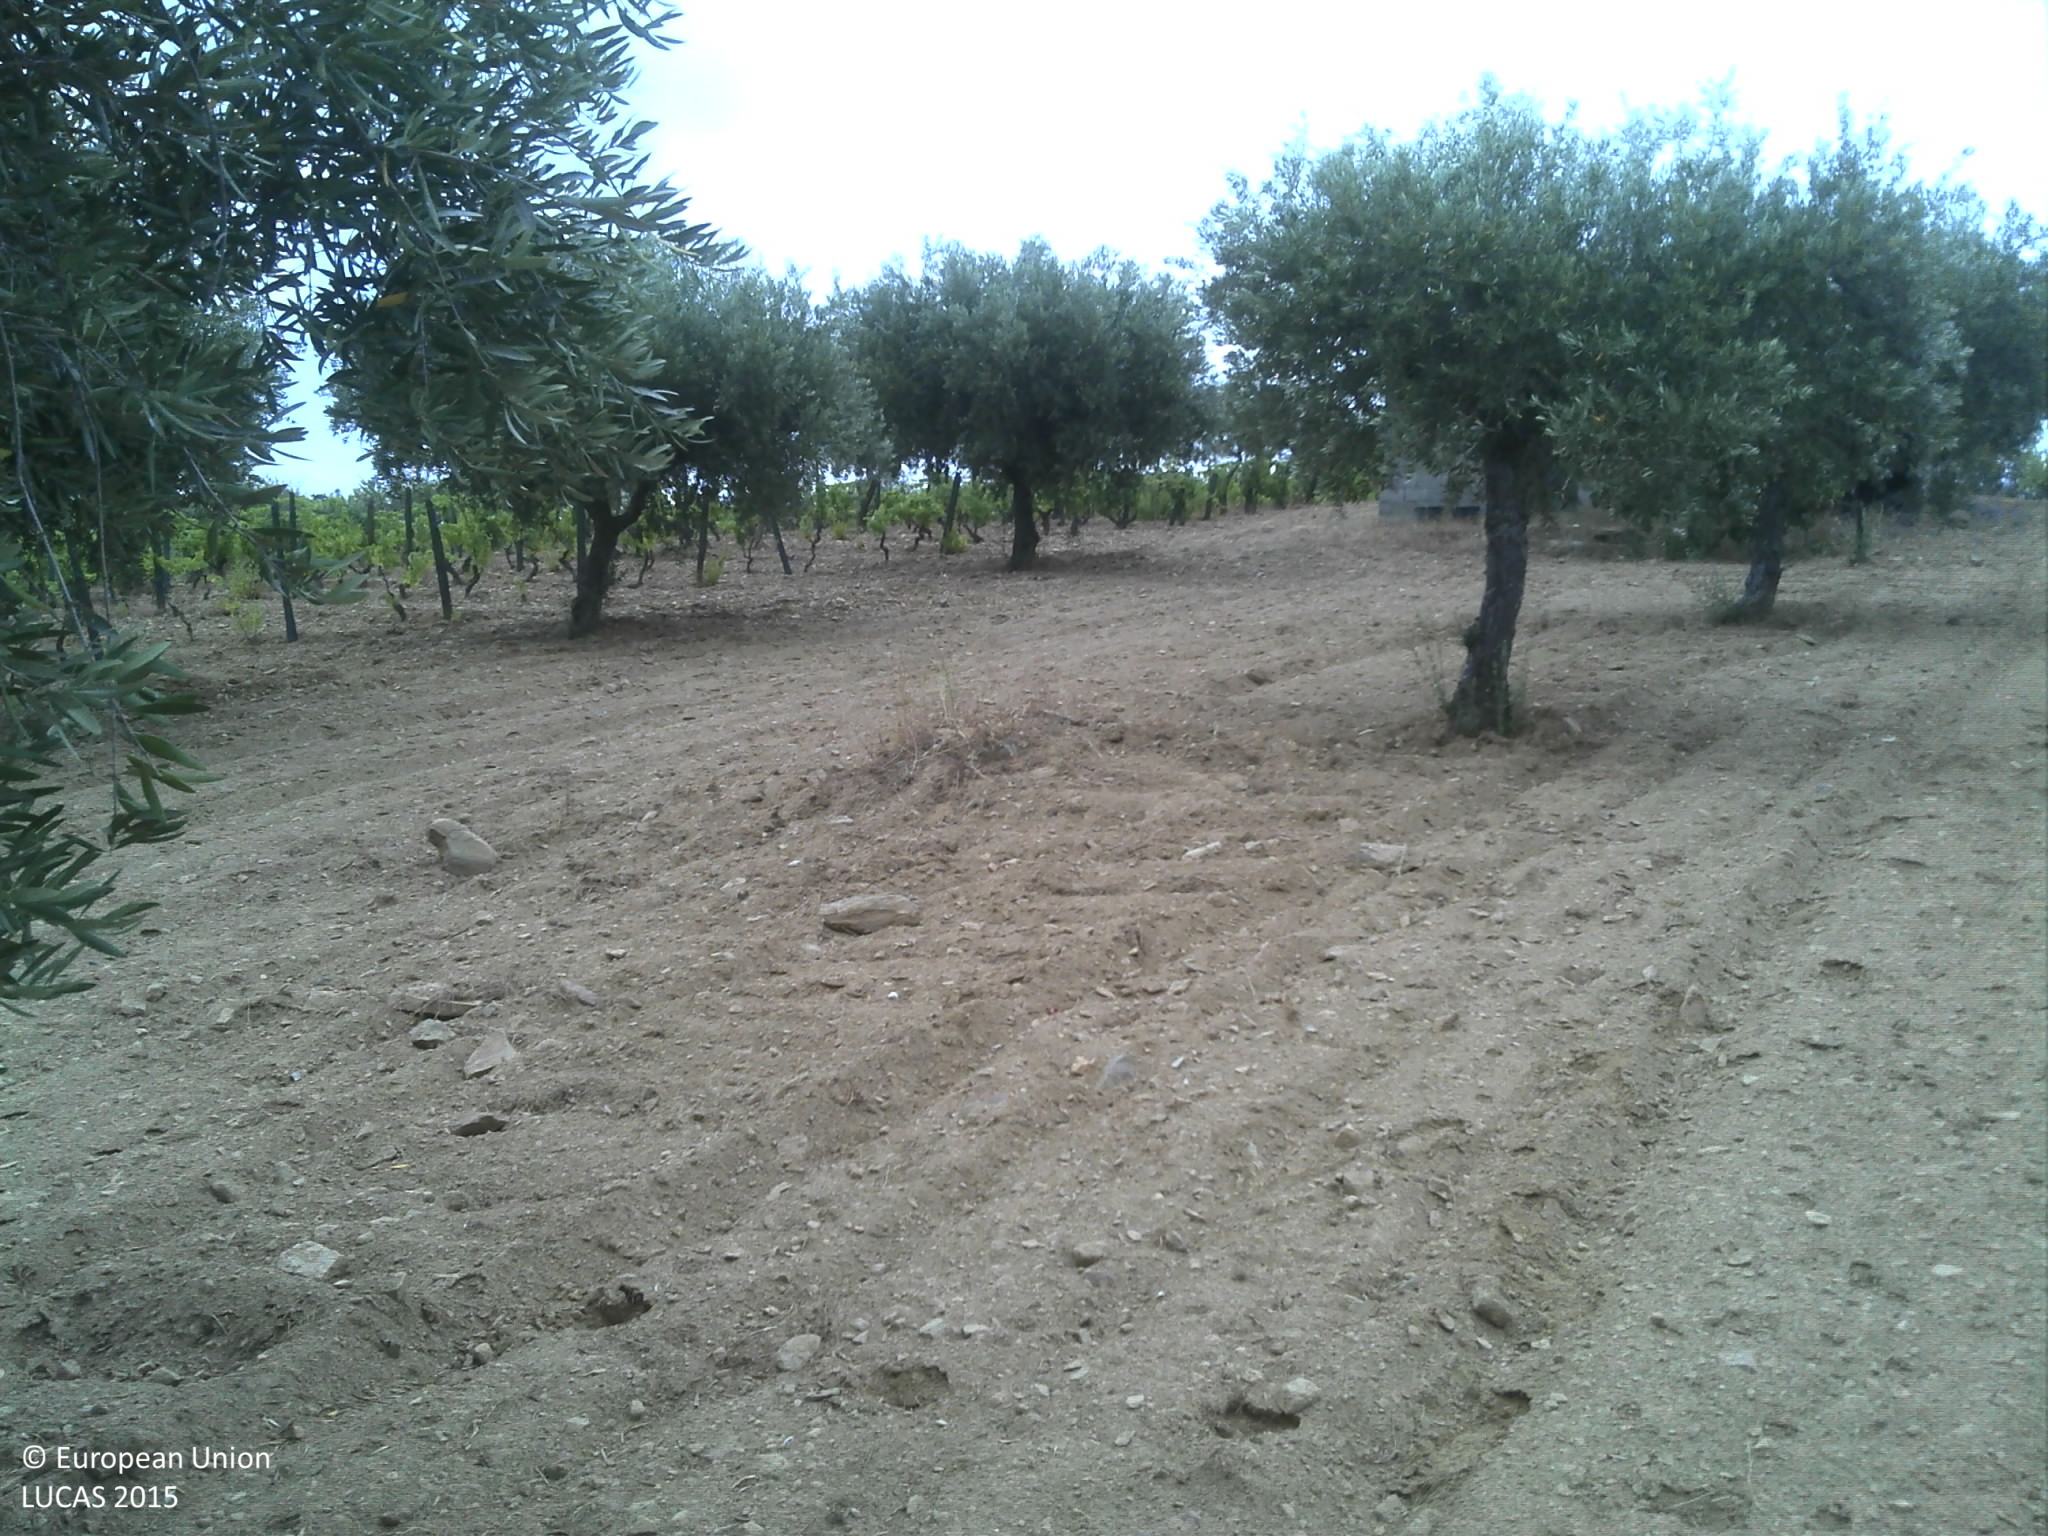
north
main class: Cropland
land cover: Olive groves
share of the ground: < 10 %
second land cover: Other bare soil
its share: > 75 %
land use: Agriculture (excluding fallow land and kitchen gardens)
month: July
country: PT
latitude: 41.0488
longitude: -7.2579
